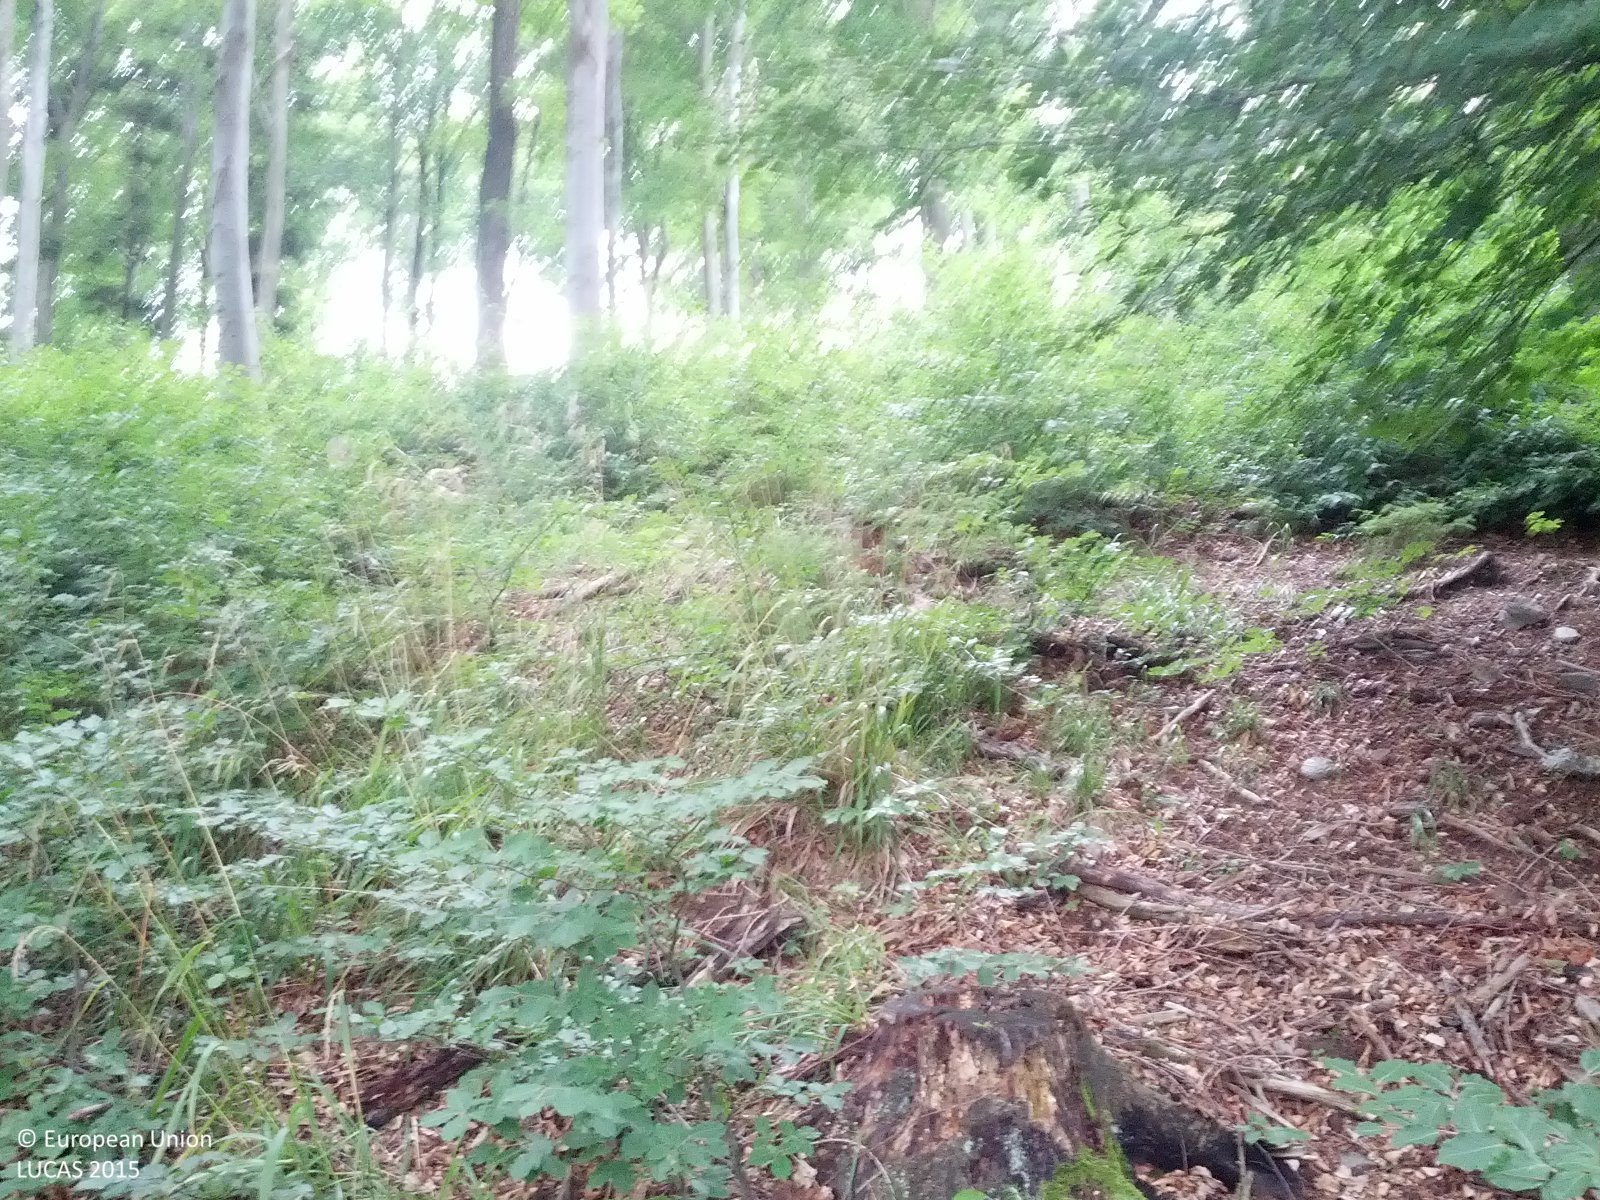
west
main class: Woodland
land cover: Other mixed woodland
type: alpine coniferous forest
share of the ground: > 75 %
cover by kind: broadleaved forest trees 40 %, coniferous forest trees 35 %, shrubs 10 %, herbaceous plants 10 %, unconsolidated bare surface 5 %
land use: Forestry
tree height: > 5 m
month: July
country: AT
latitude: 47.3338
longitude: 16.3949
